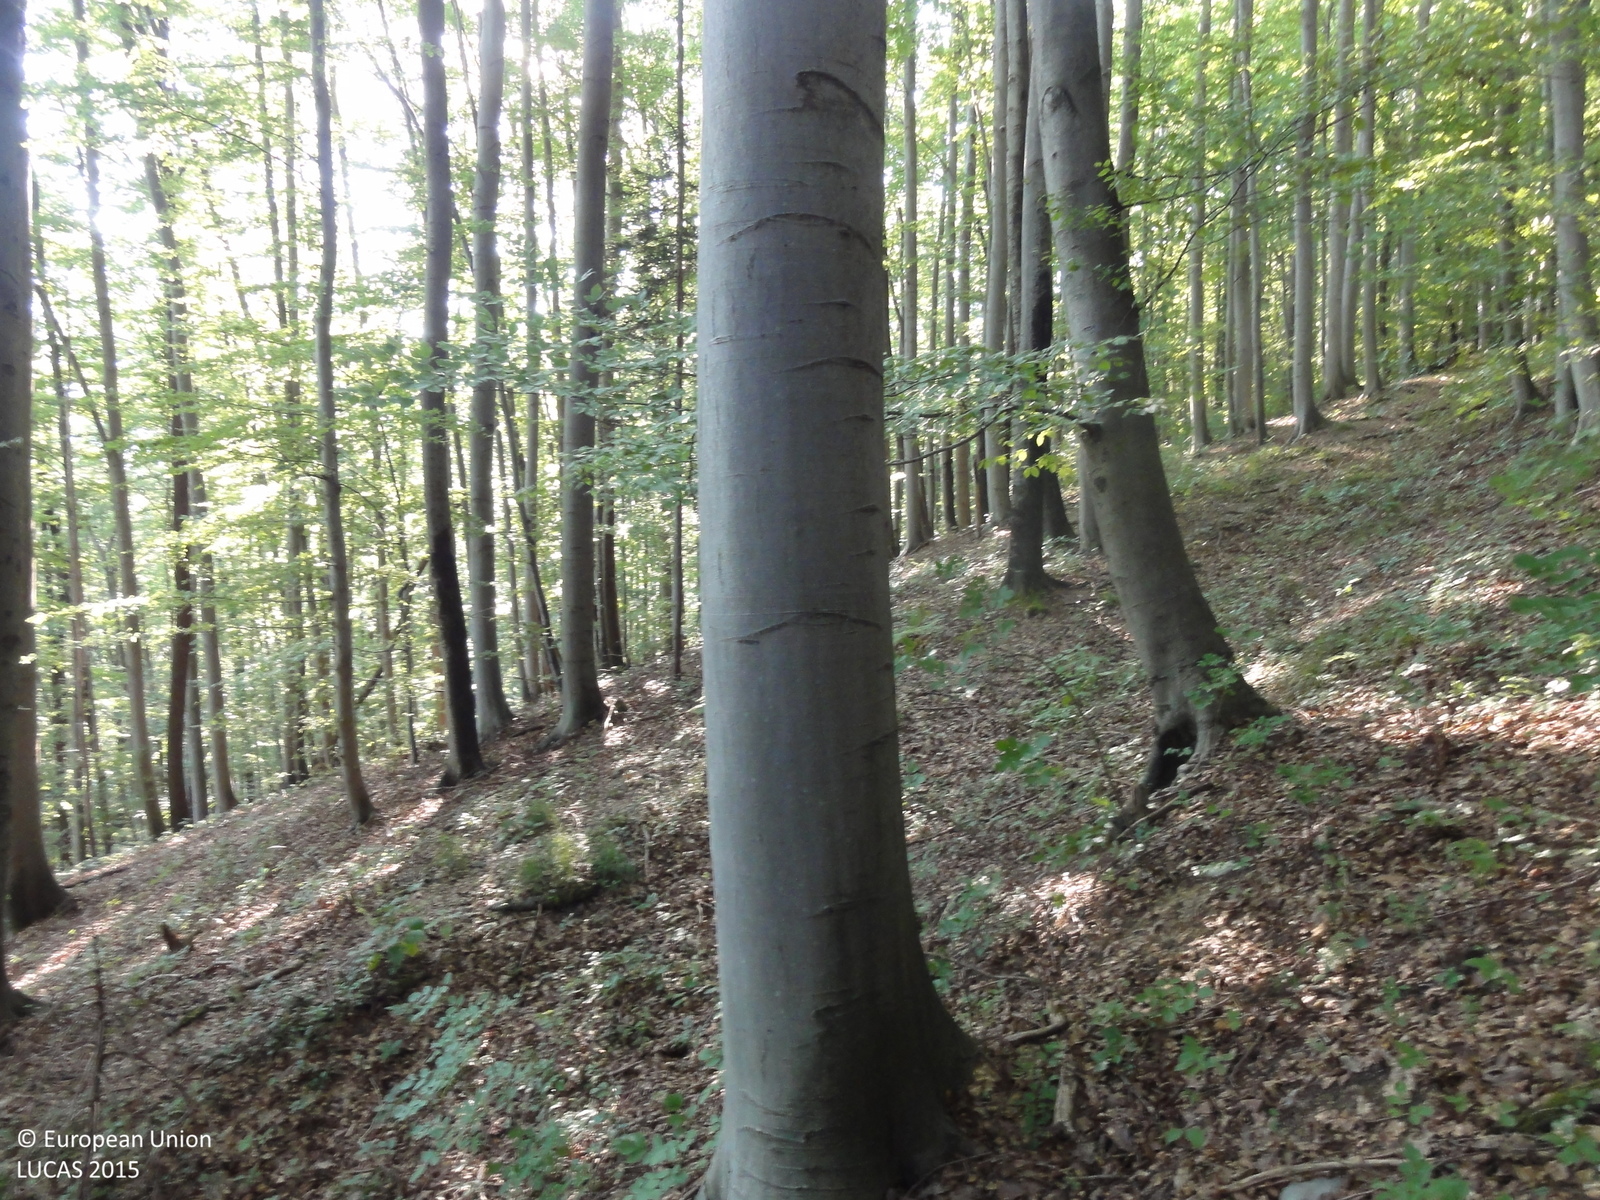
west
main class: Woodland
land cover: Broadleaved woodland
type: beech forest
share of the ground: > 75 %
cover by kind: broadleaved forest trees 95 %, coniferous forest trees 5 %
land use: Forestry
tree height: > 5 m
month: August
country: SI
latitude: 46.0657
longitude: 15.1294
